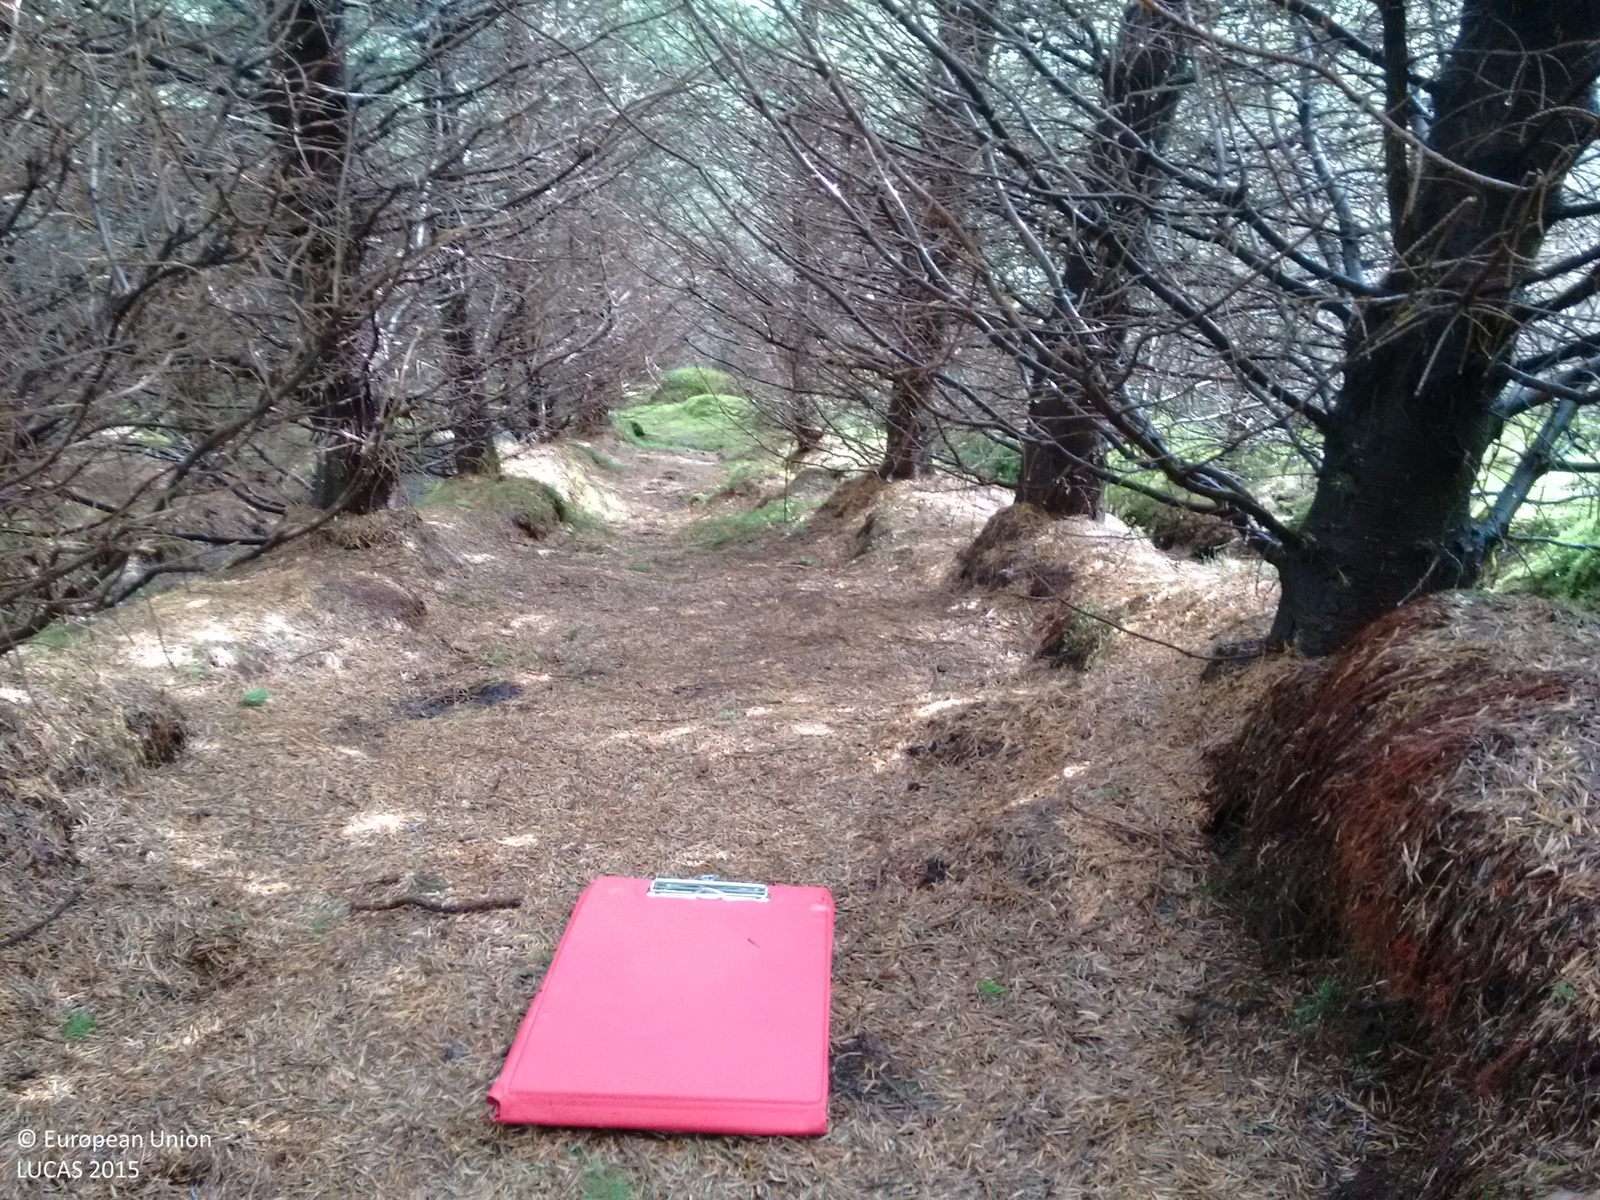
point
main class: Woodland
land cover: Spruce dominated coniferous woodland
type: exotic forest
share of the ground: > 75 %
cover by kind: coniferous forest trees 100 %
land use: Forestry
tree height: > 5 m
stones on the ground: < 10 %
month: May
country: GB
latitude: 56.1098
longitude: -5.1152
